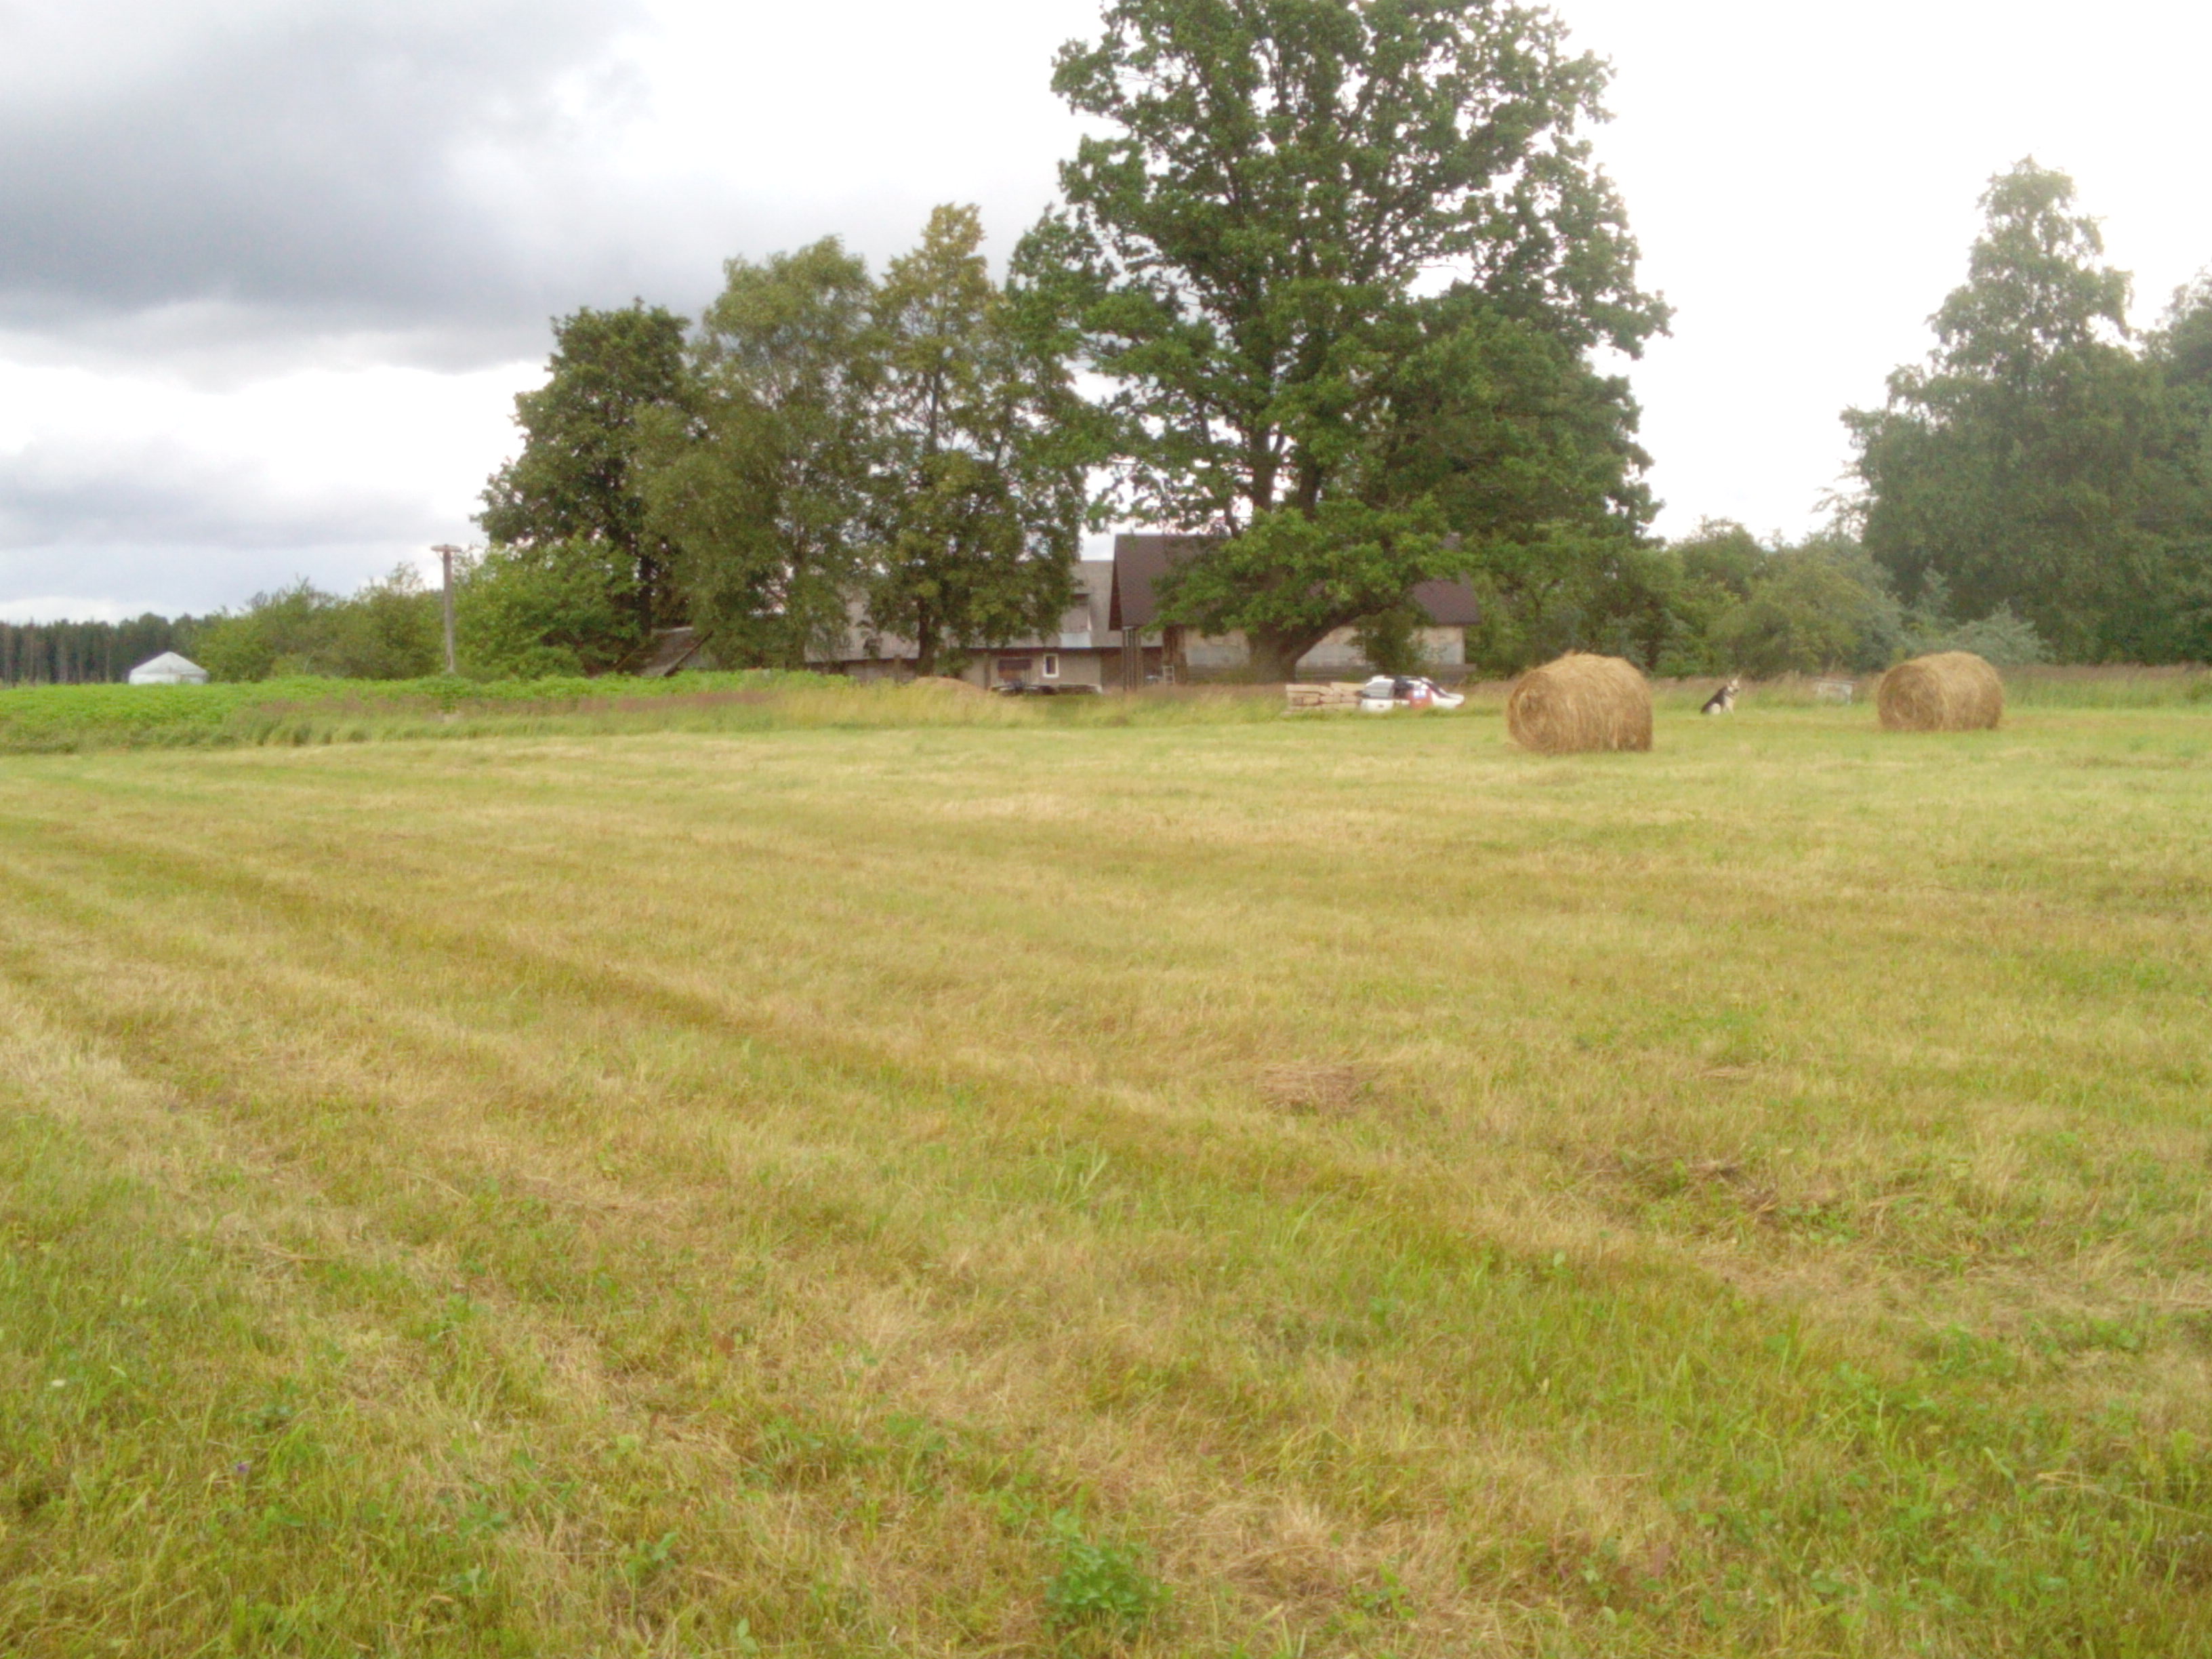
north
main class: Grassland
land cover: Grassland without tree/shrub cover
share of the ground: > 75 %
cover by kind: herbaceous plants 100 %
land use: Agriculture (excluding fallow land and kitchen gardens)
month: July
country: LV
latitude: 56.9657
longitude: 22.0383
